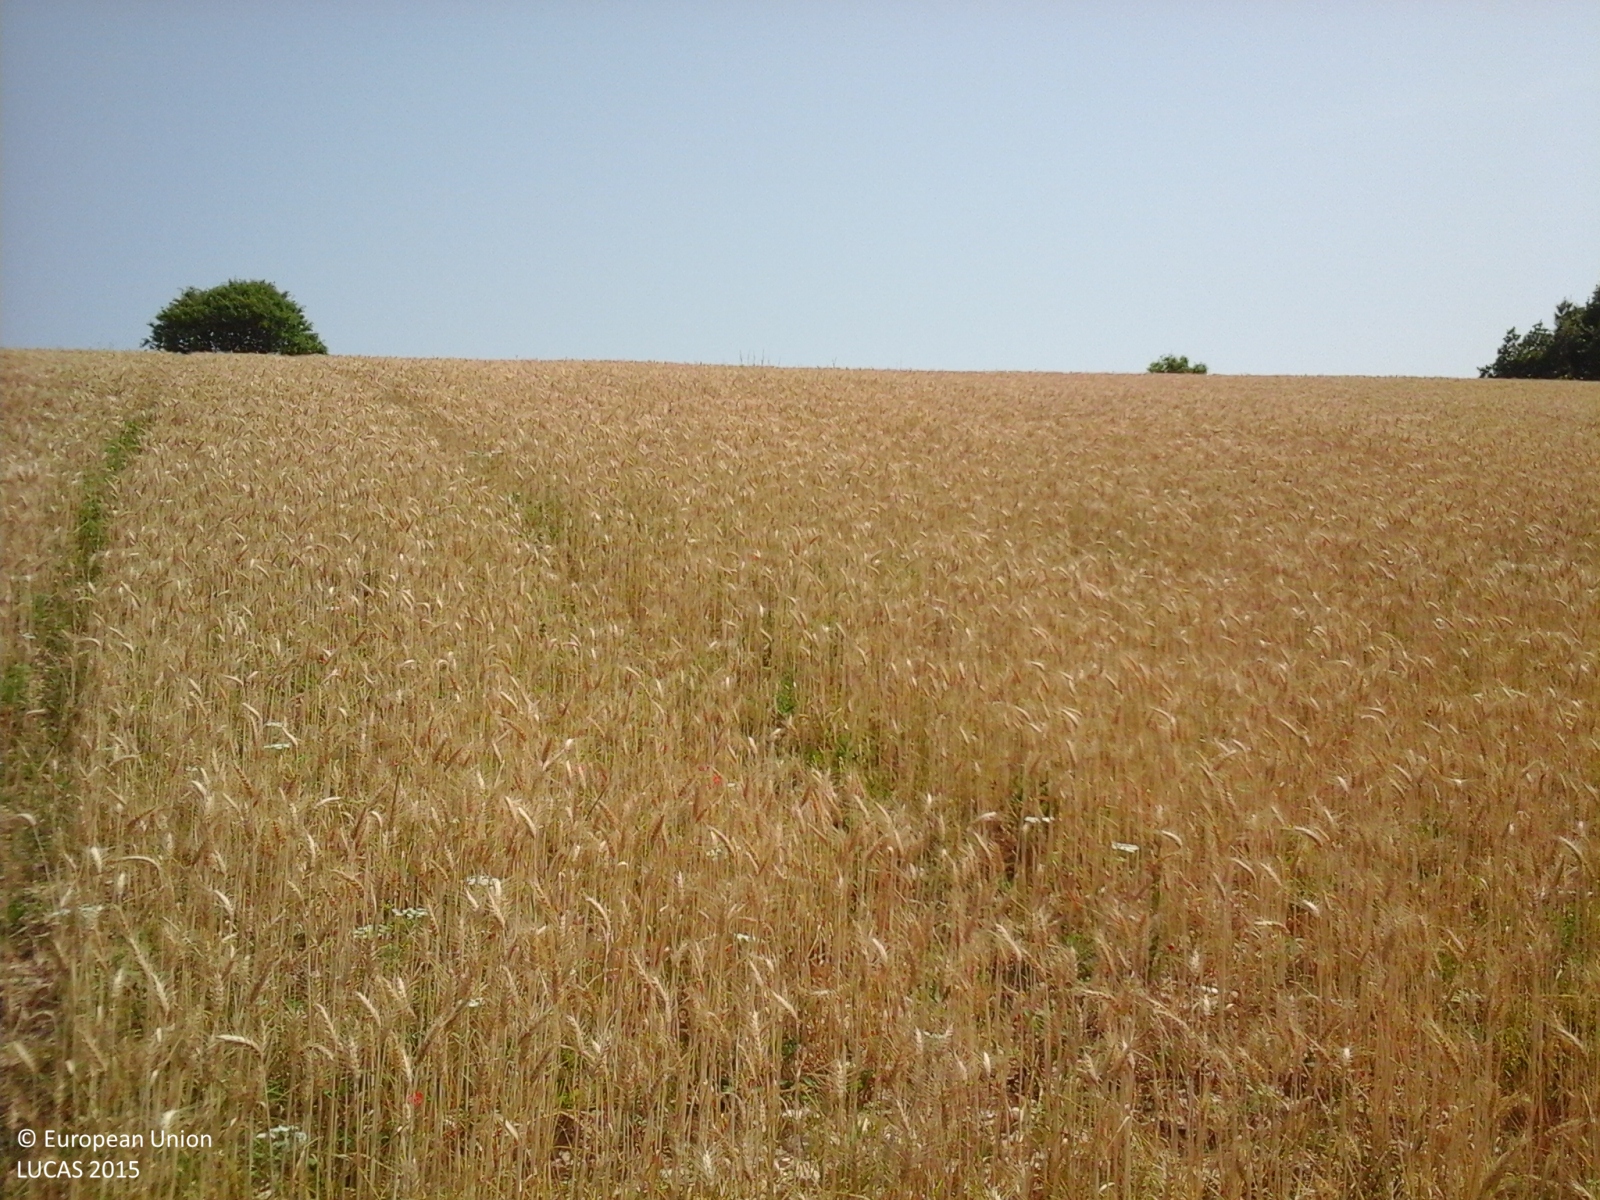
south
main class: Cropland
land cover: Common wheat
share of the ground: > 75 %
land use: Agriculture (excluding fallow land and kitchen gardens)
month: July
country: IT
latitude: 43.0533
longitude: 13.7837
